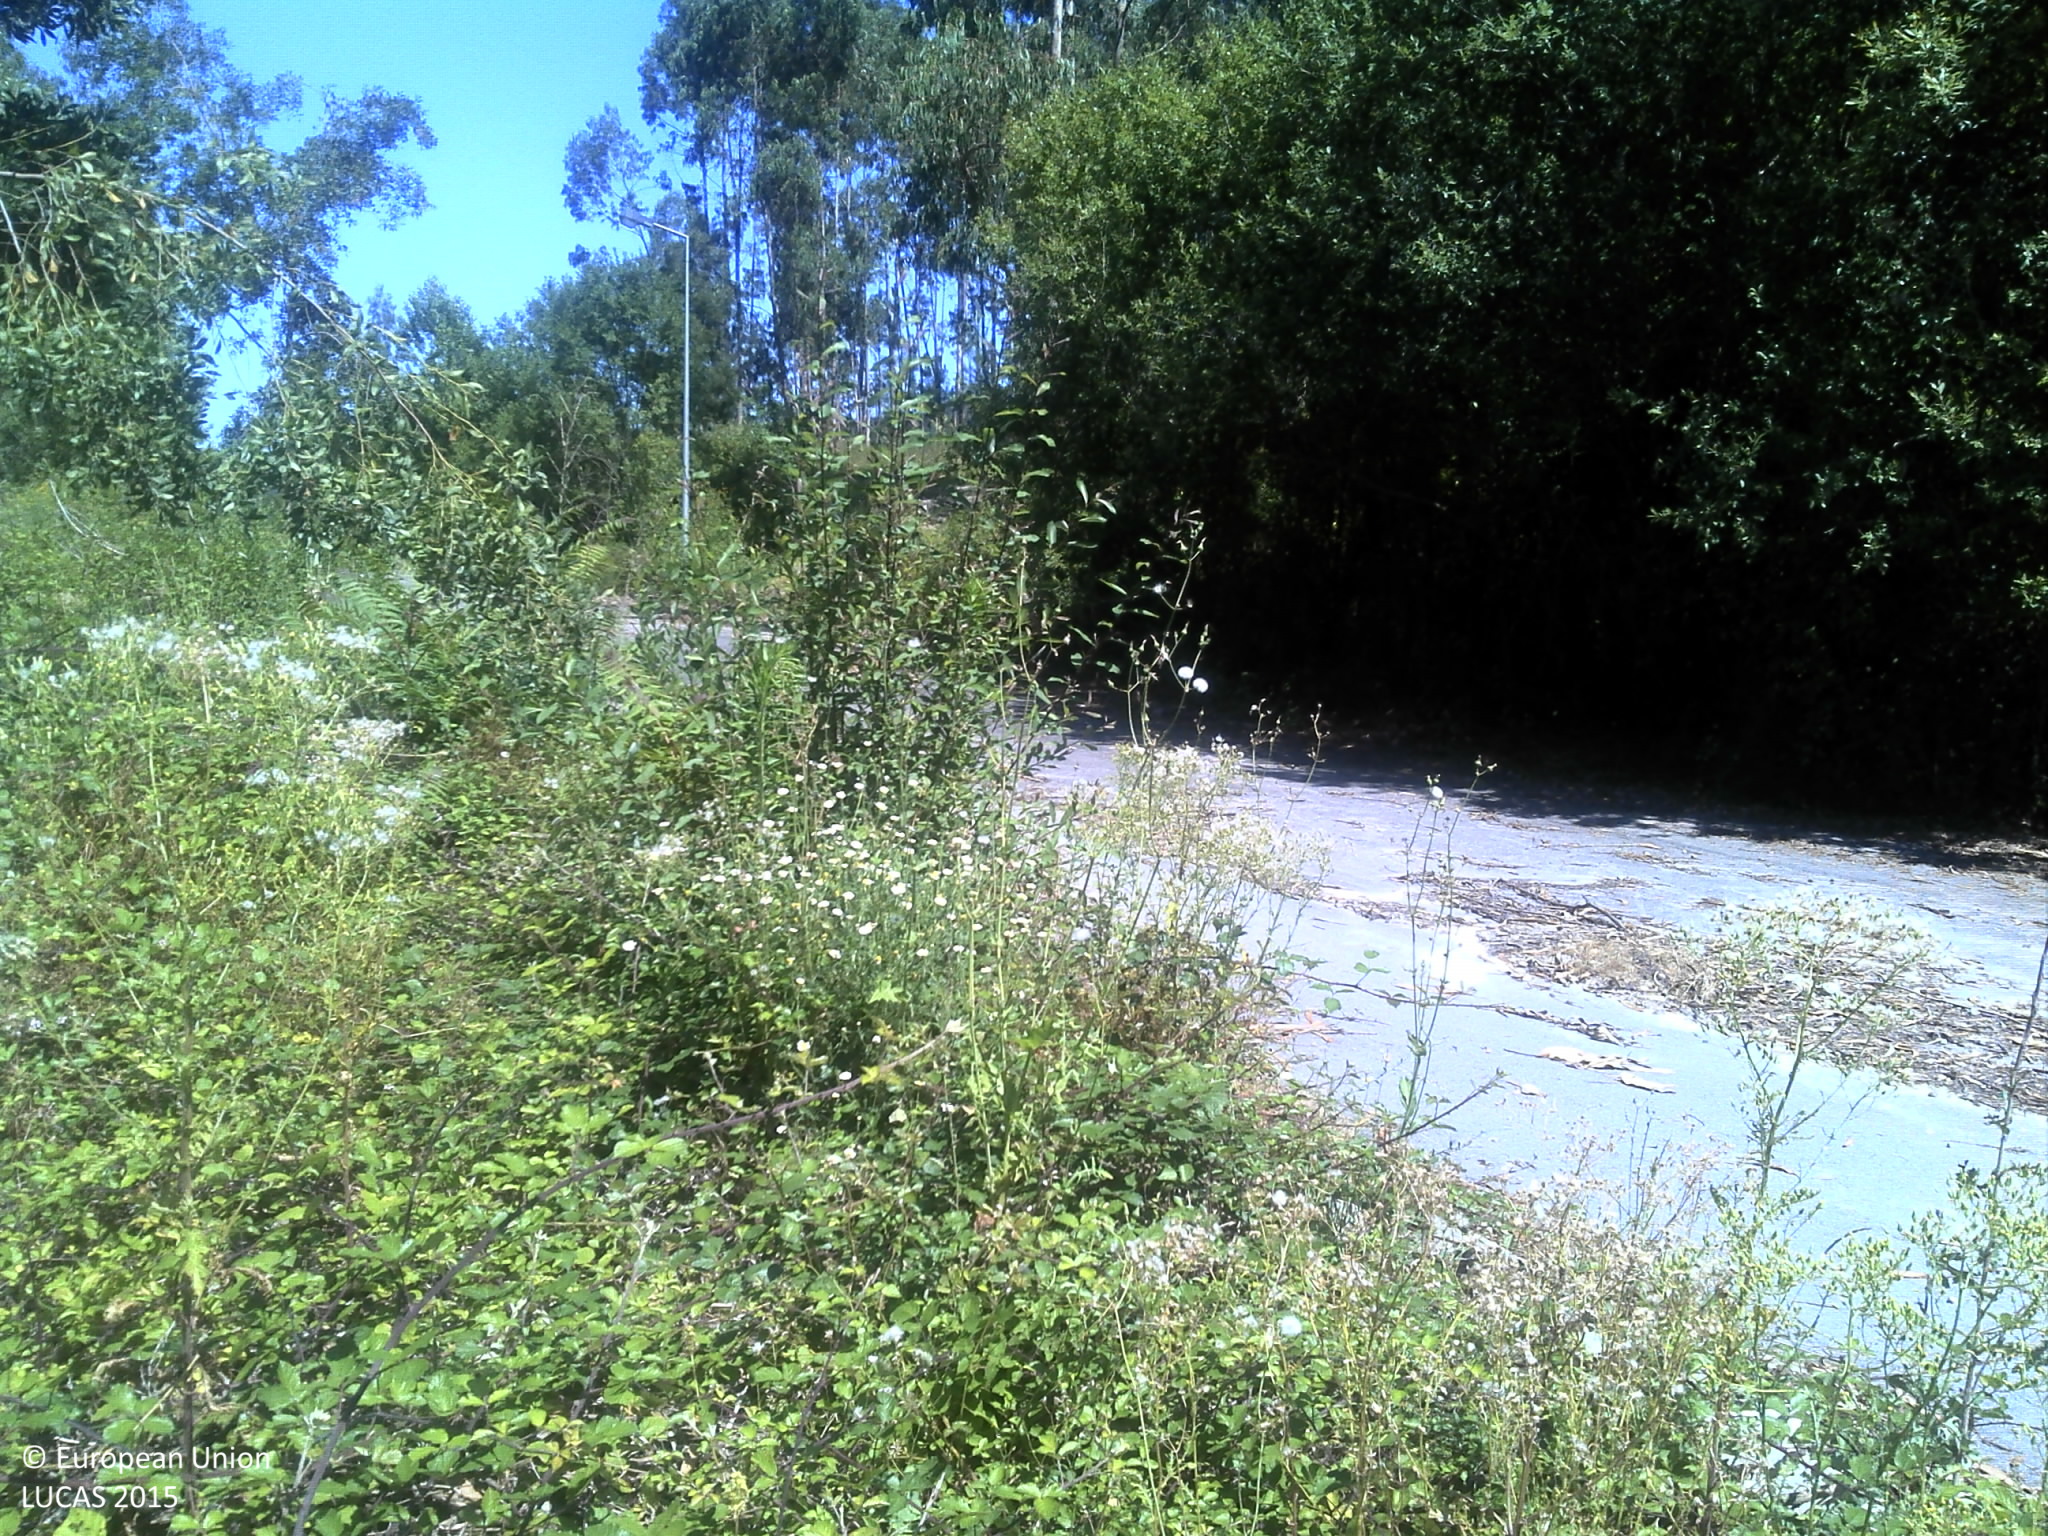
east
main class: Shrubland
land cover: Shrubland with sparse tree cover
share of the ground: > 75 %
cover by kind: shrubs 85 %, unconsolidated bare surface 10 %, broadleaved forest trees 5 %
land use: Semi-natural and natural areas not in use
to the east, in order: Shrubland with sparse tree cover; Paved roads, cycling and walking lanes; Shrubland with sparse tree cover; Broadleaved woodland; Shrubland with sparse tree cover
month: June
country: PT
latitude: 41.5274
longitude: -8.2819
